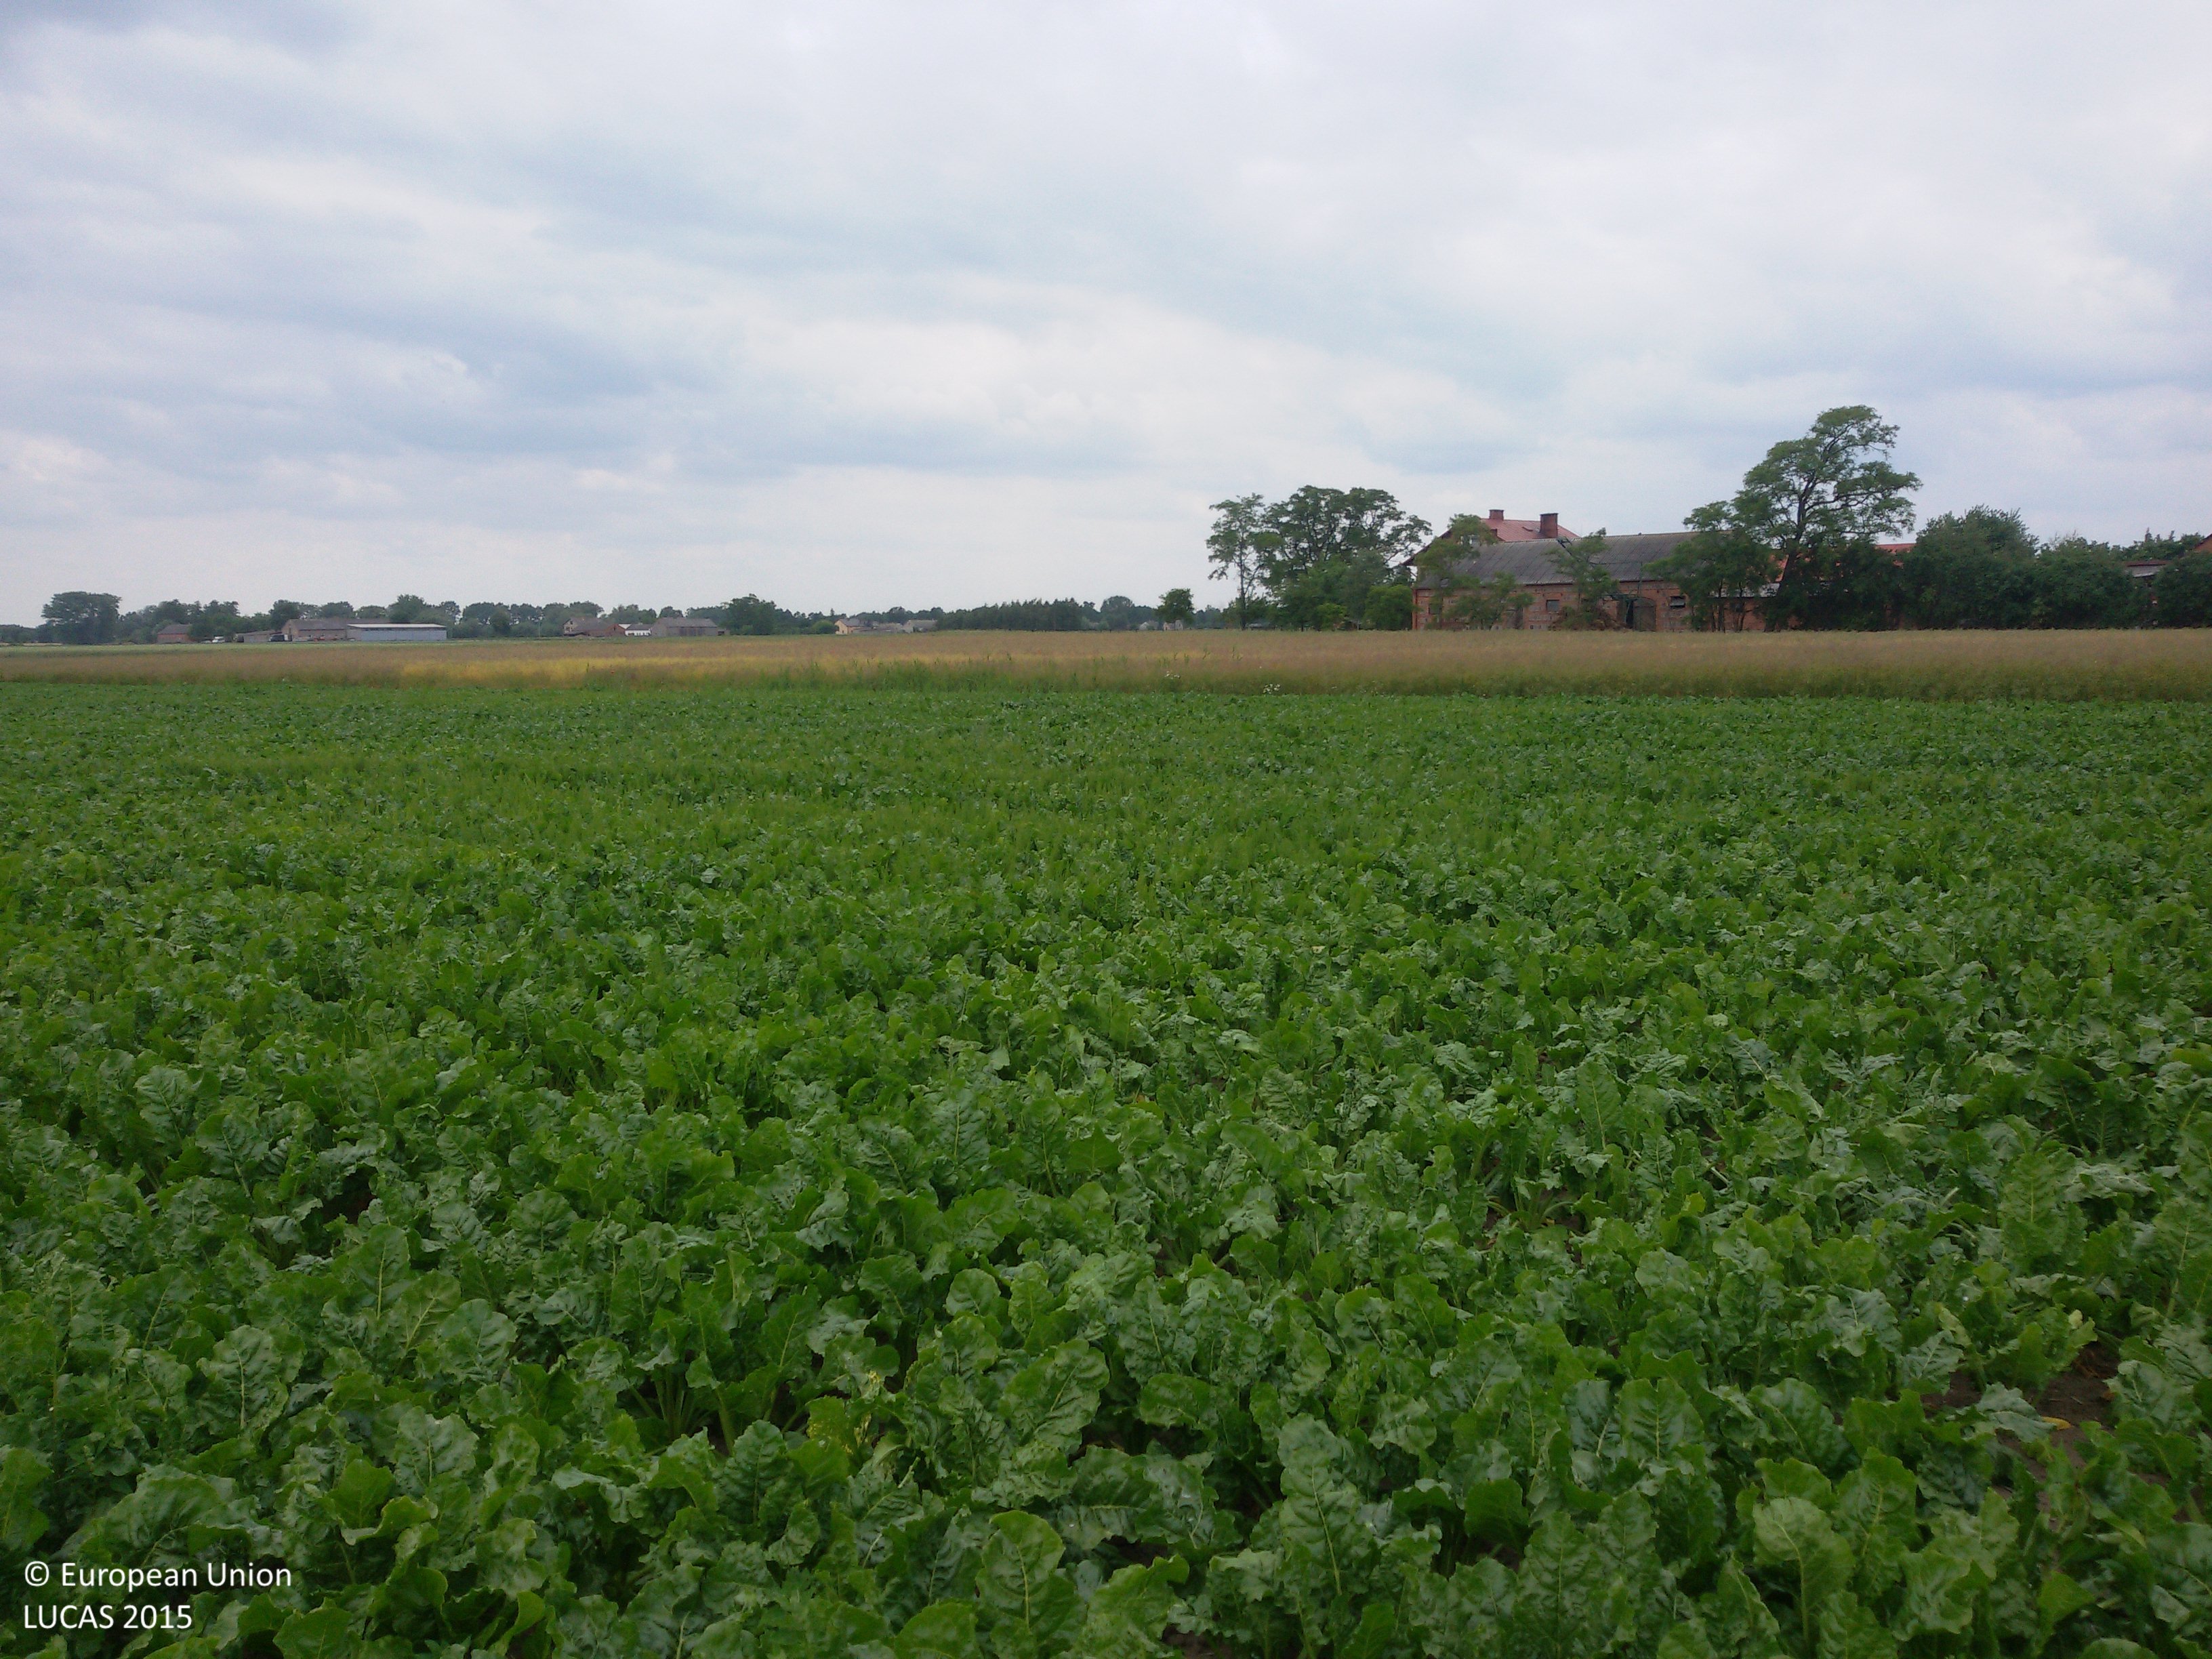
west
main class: Cropland
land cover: Sugar beet
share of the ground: > 75 %
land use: Agriculture (excluding fallow land and kitchen gardens)
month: June
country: PL
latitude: 52.3116
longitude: 19.8439
